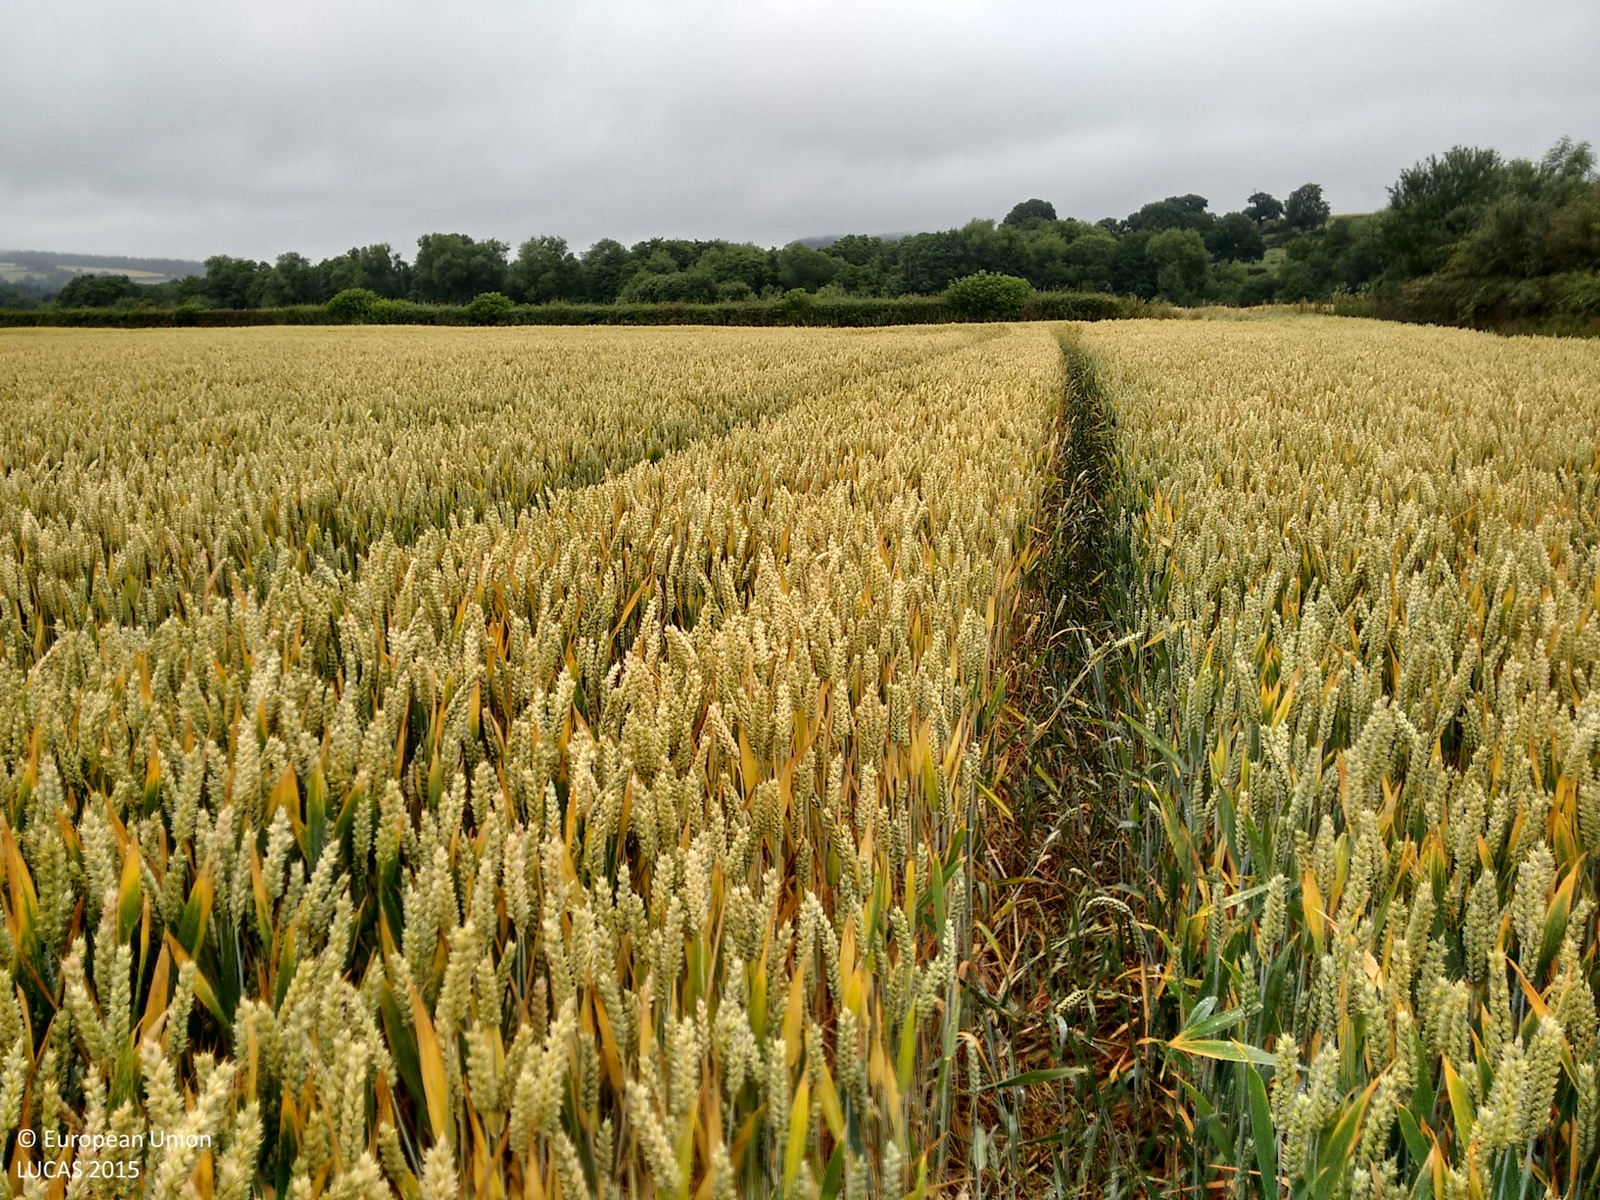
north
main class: Cropland
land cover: Common wheat
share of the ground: > 75 %
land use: Agriculture (excluding fallow land and kitchen gardens)
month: July
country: GB
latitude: 52.2601
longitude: -2.8331
